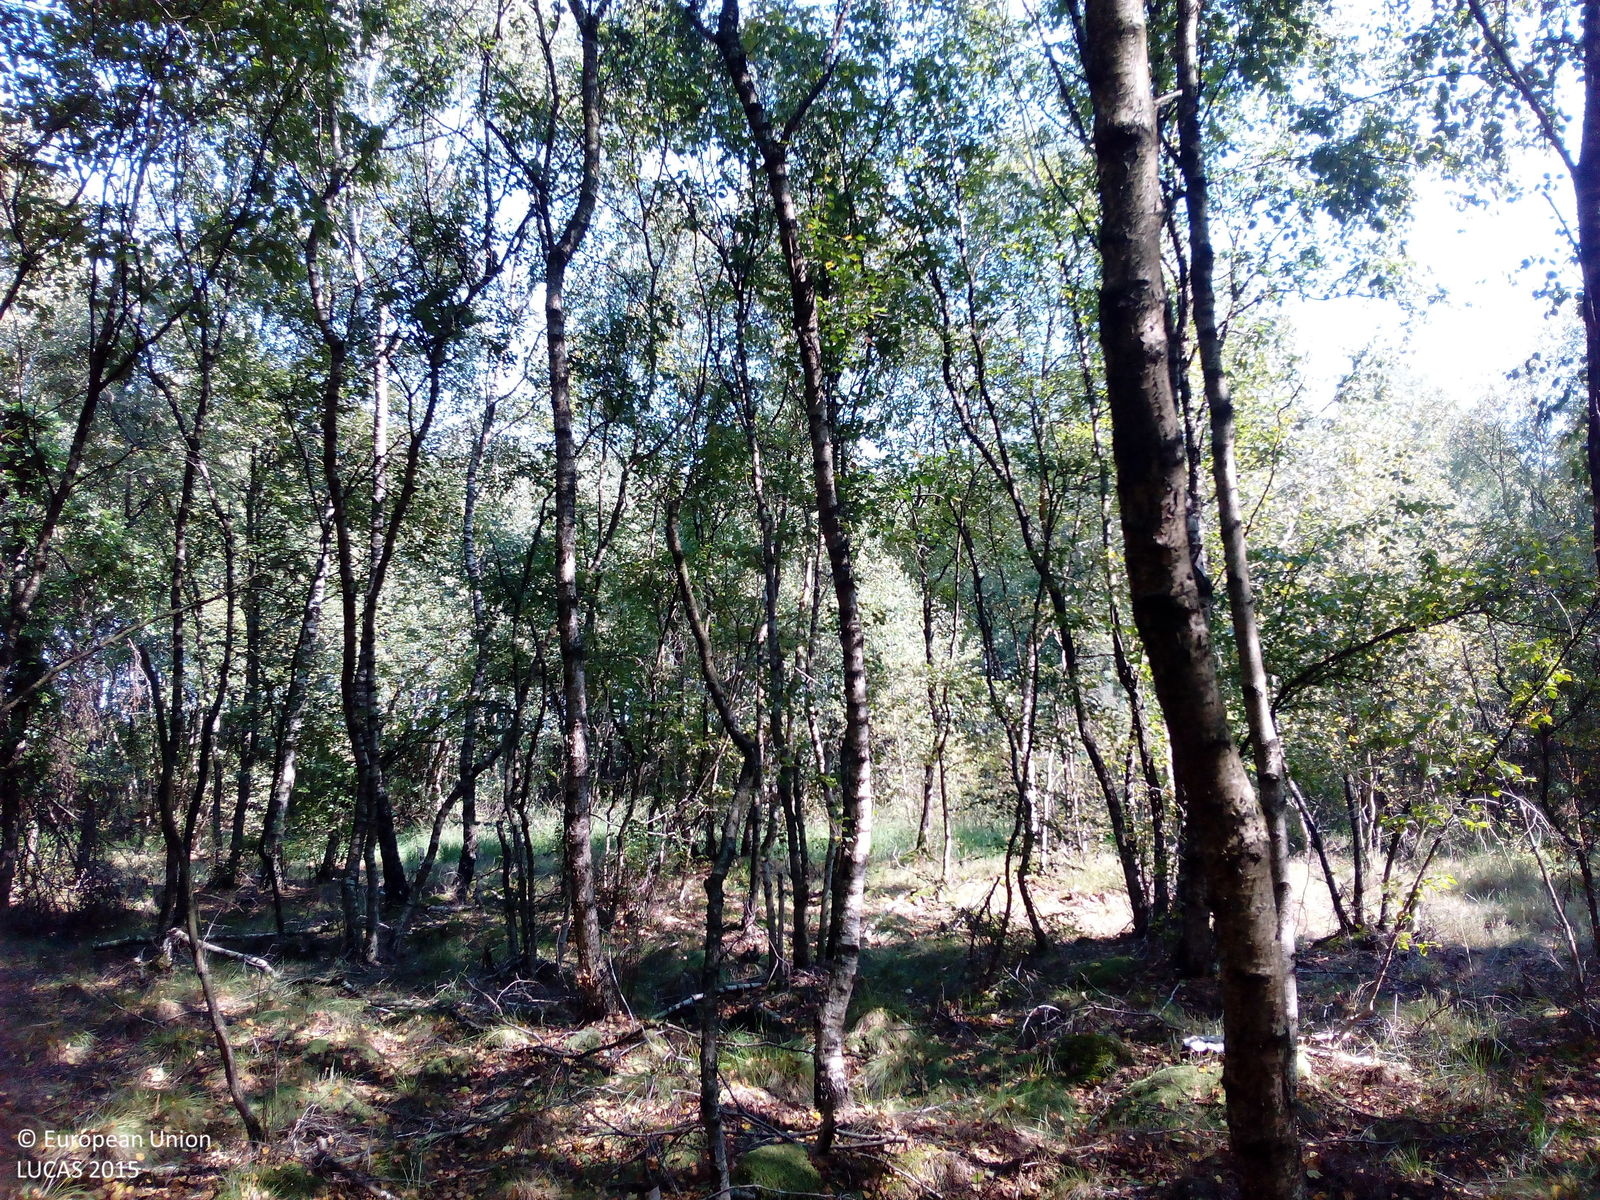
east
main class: Woodland
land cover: Broadleaved woodland
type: non-riverine alder, birch or aspen forest
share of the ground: > 75 %
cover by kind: broadleaved forest trees 80 %, herbaceous plants 10 %, shrubs 5 %, lichens and mosses 5 %
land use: Forestry
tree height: > 5 m
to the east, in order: Broadleaved woodland; Ditches and canals; Maize
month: August
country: DE
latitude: 52.7921
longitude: 7.9986
